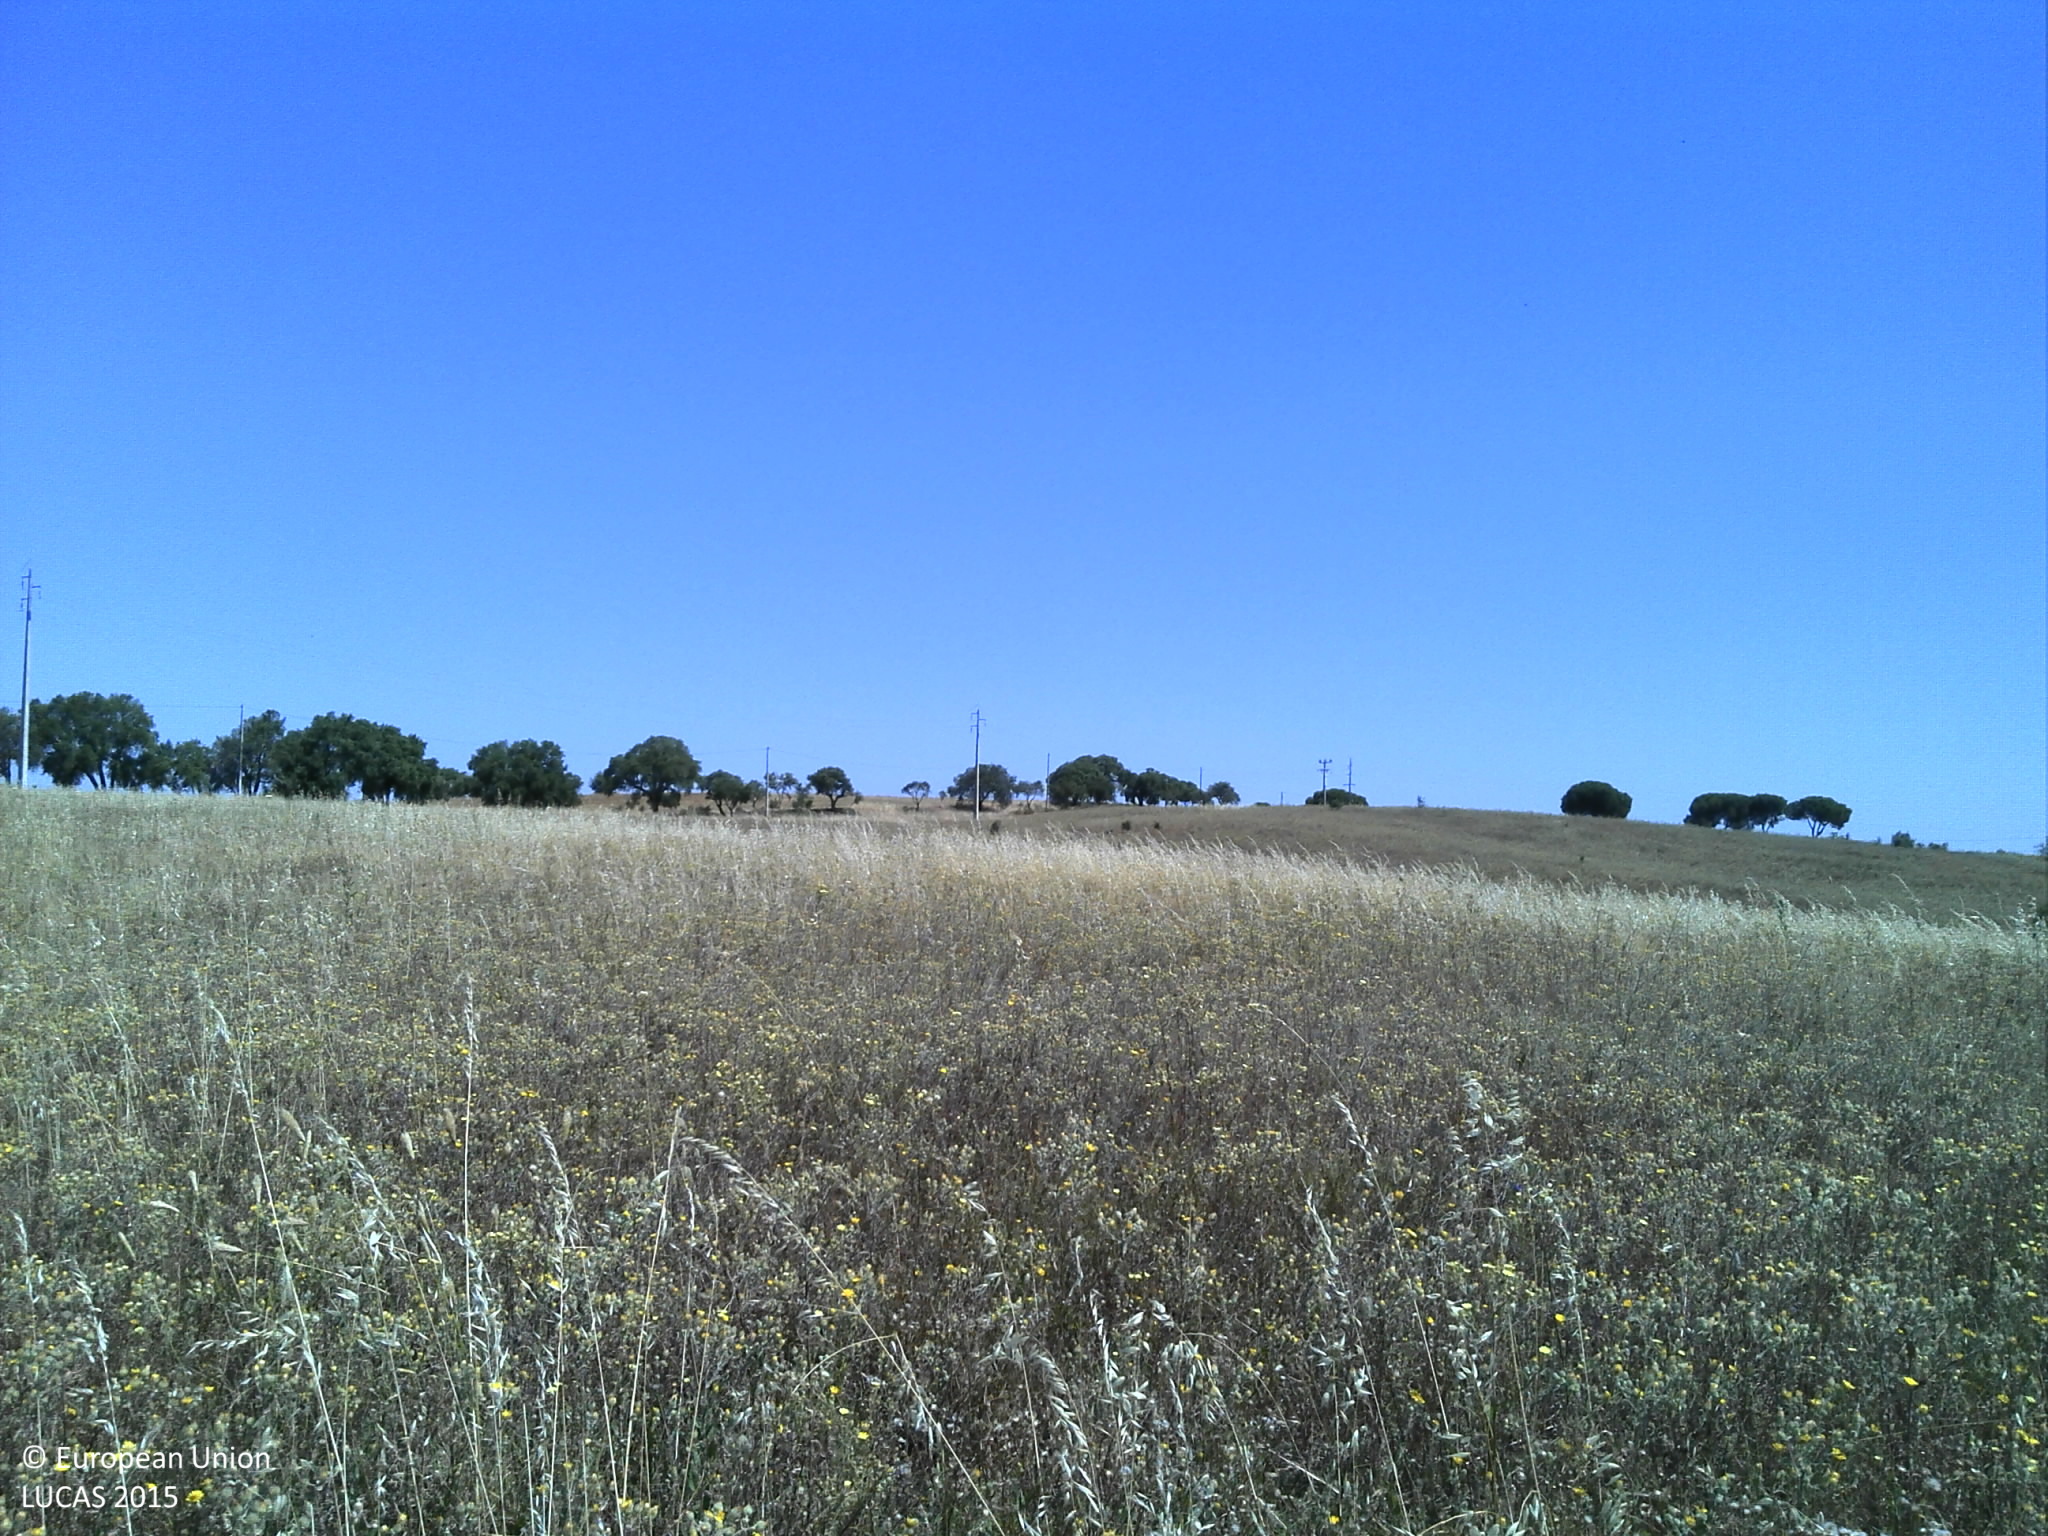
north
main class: Grassland
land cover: Spontaneously vegetated surfaces
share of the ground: > 75 %
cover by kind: herbaceous plants 75 %, unconsolidated bare surface 25 %
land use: Fallow land
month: May
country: PT
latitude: 38.8252
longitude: -7.8149
